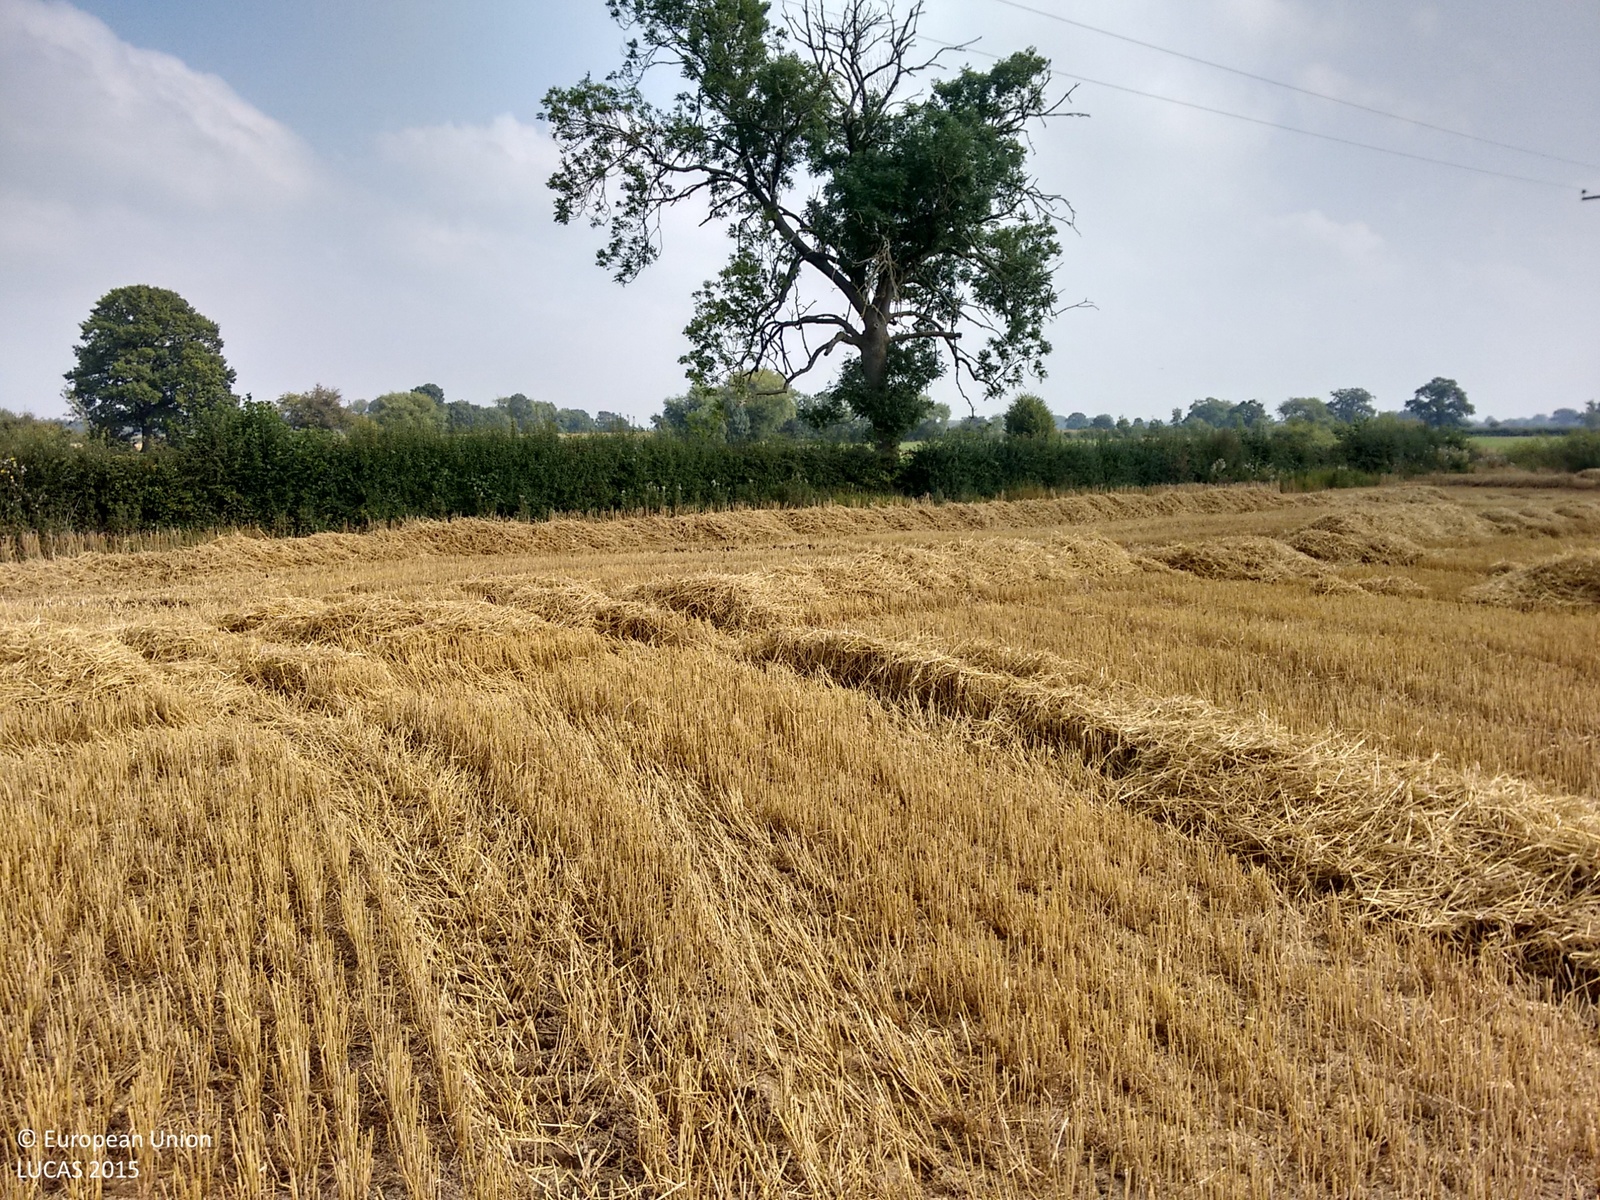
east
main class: Cropland
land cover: Barley
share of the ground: < 10 %
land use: Agriculture (excluding fallow land and kitchen gardens)
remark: Harvested field
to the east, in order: Barley; Electric lines; Barley; Managed hedges; Grassland without tree/shrub cover; Inland fresh running water; Grassland without tree/shrub cover
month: September
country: GB
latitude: 52.7365
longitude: -2.9743
